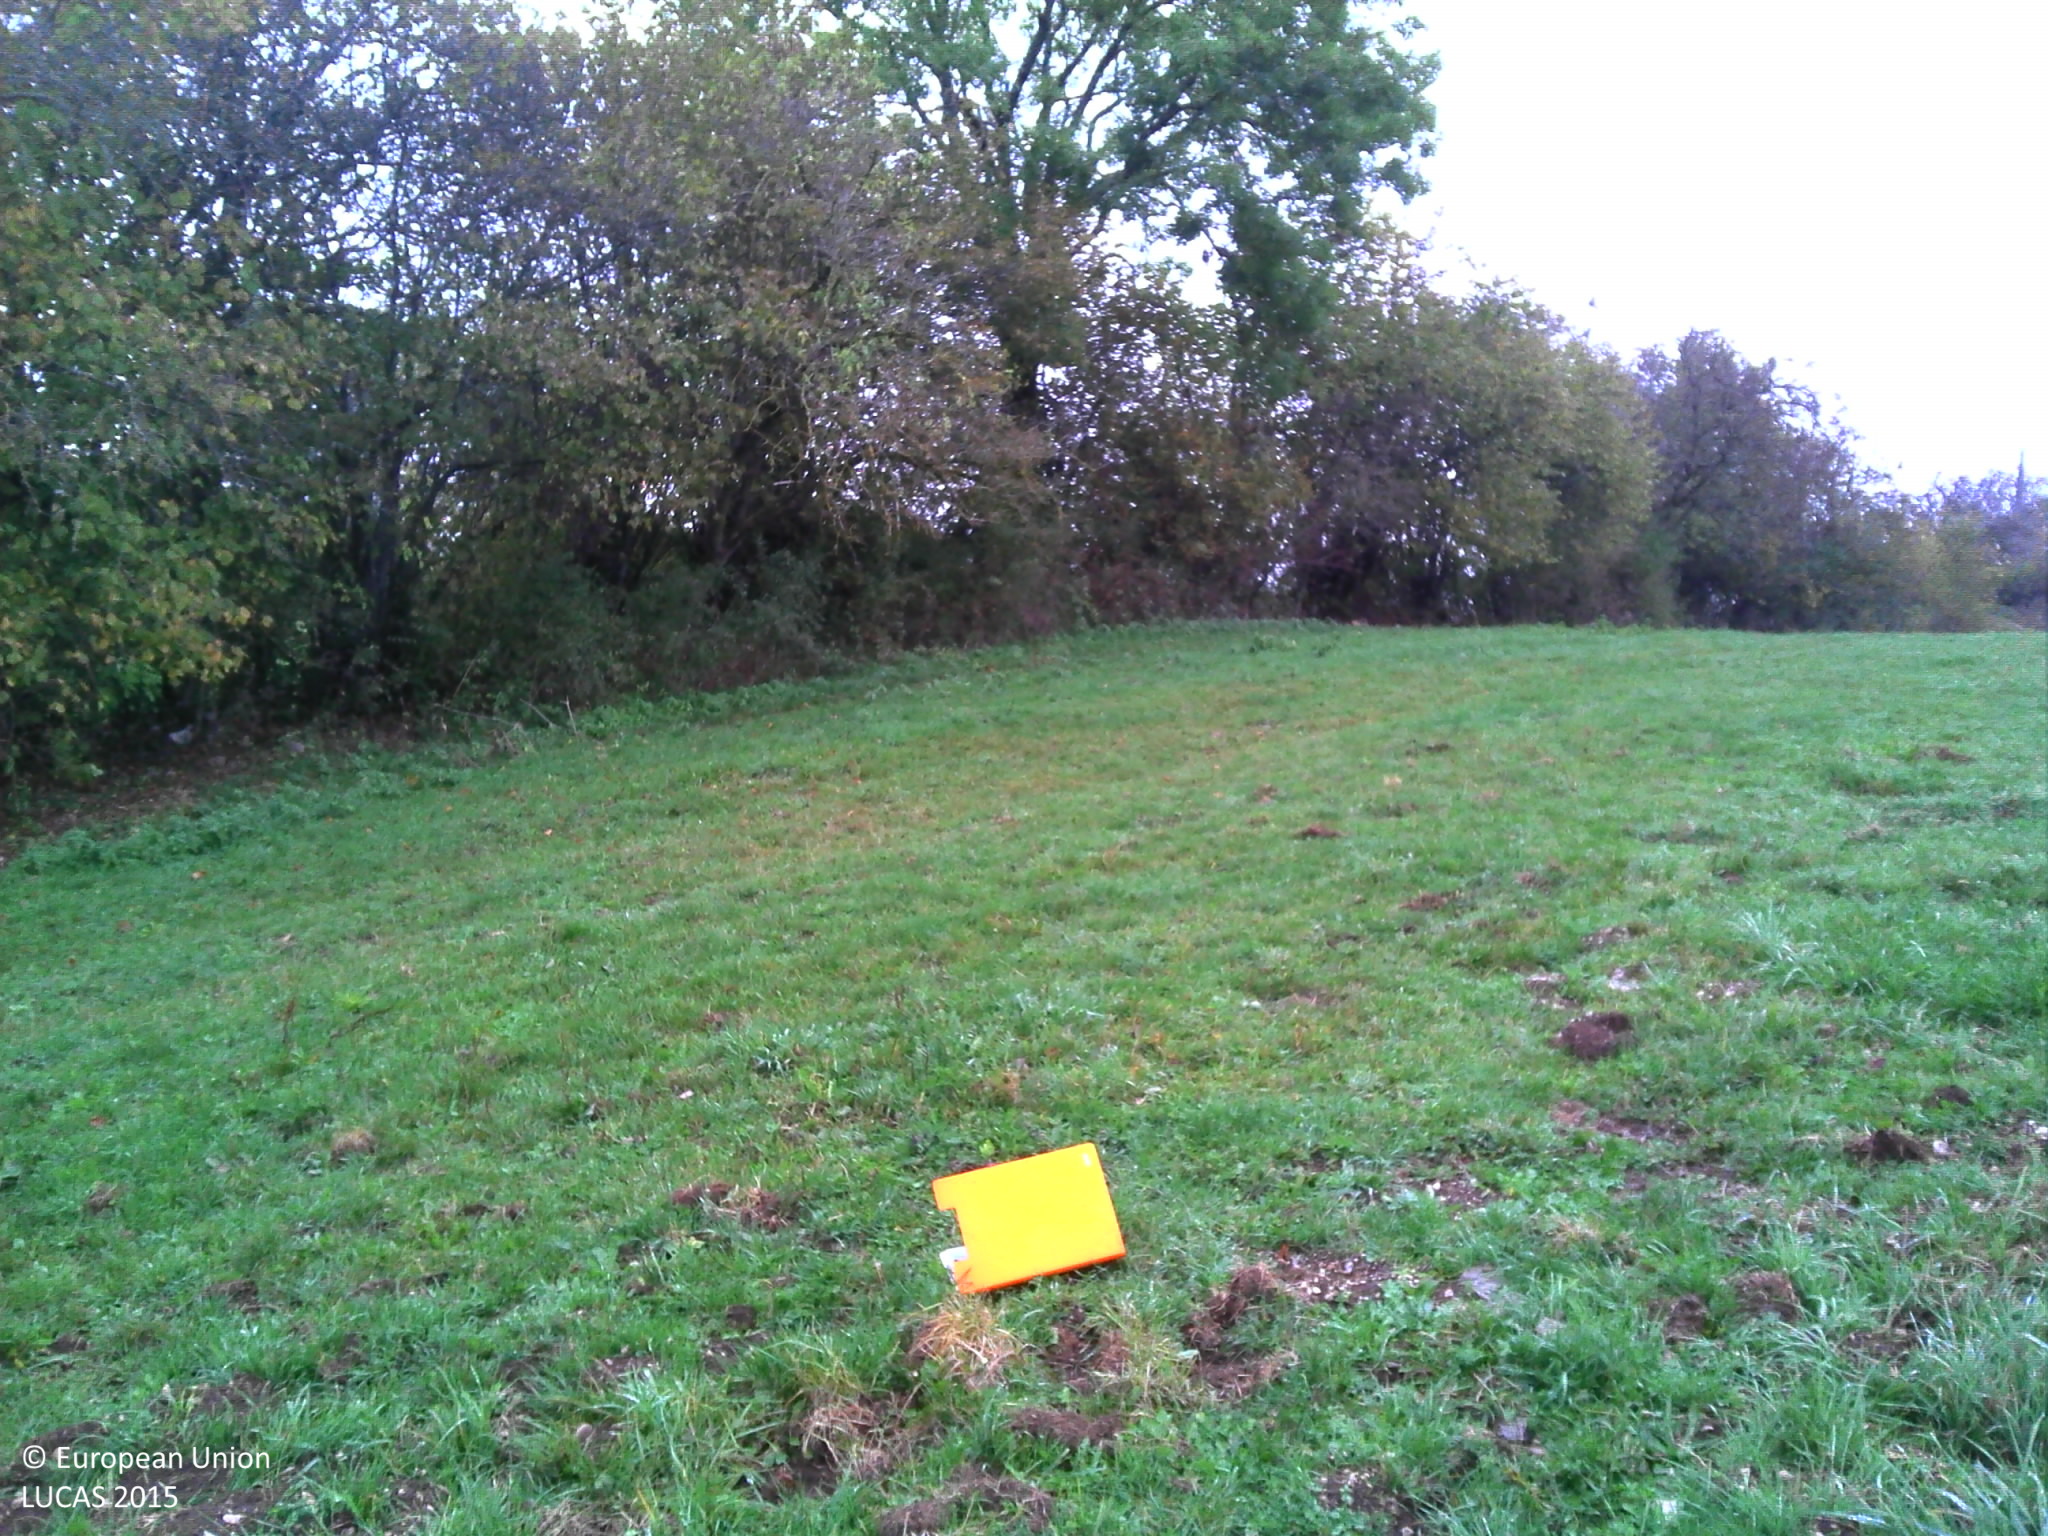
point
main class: Grassland
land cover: Grassland without tree/shrub cover
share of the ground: > 75 %
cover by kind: herbaceous plants 100 %
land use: Agriculture (excluding fallow land and kitchen gardens)
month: October
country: FR
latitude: 46.8818
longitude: 6.2888
